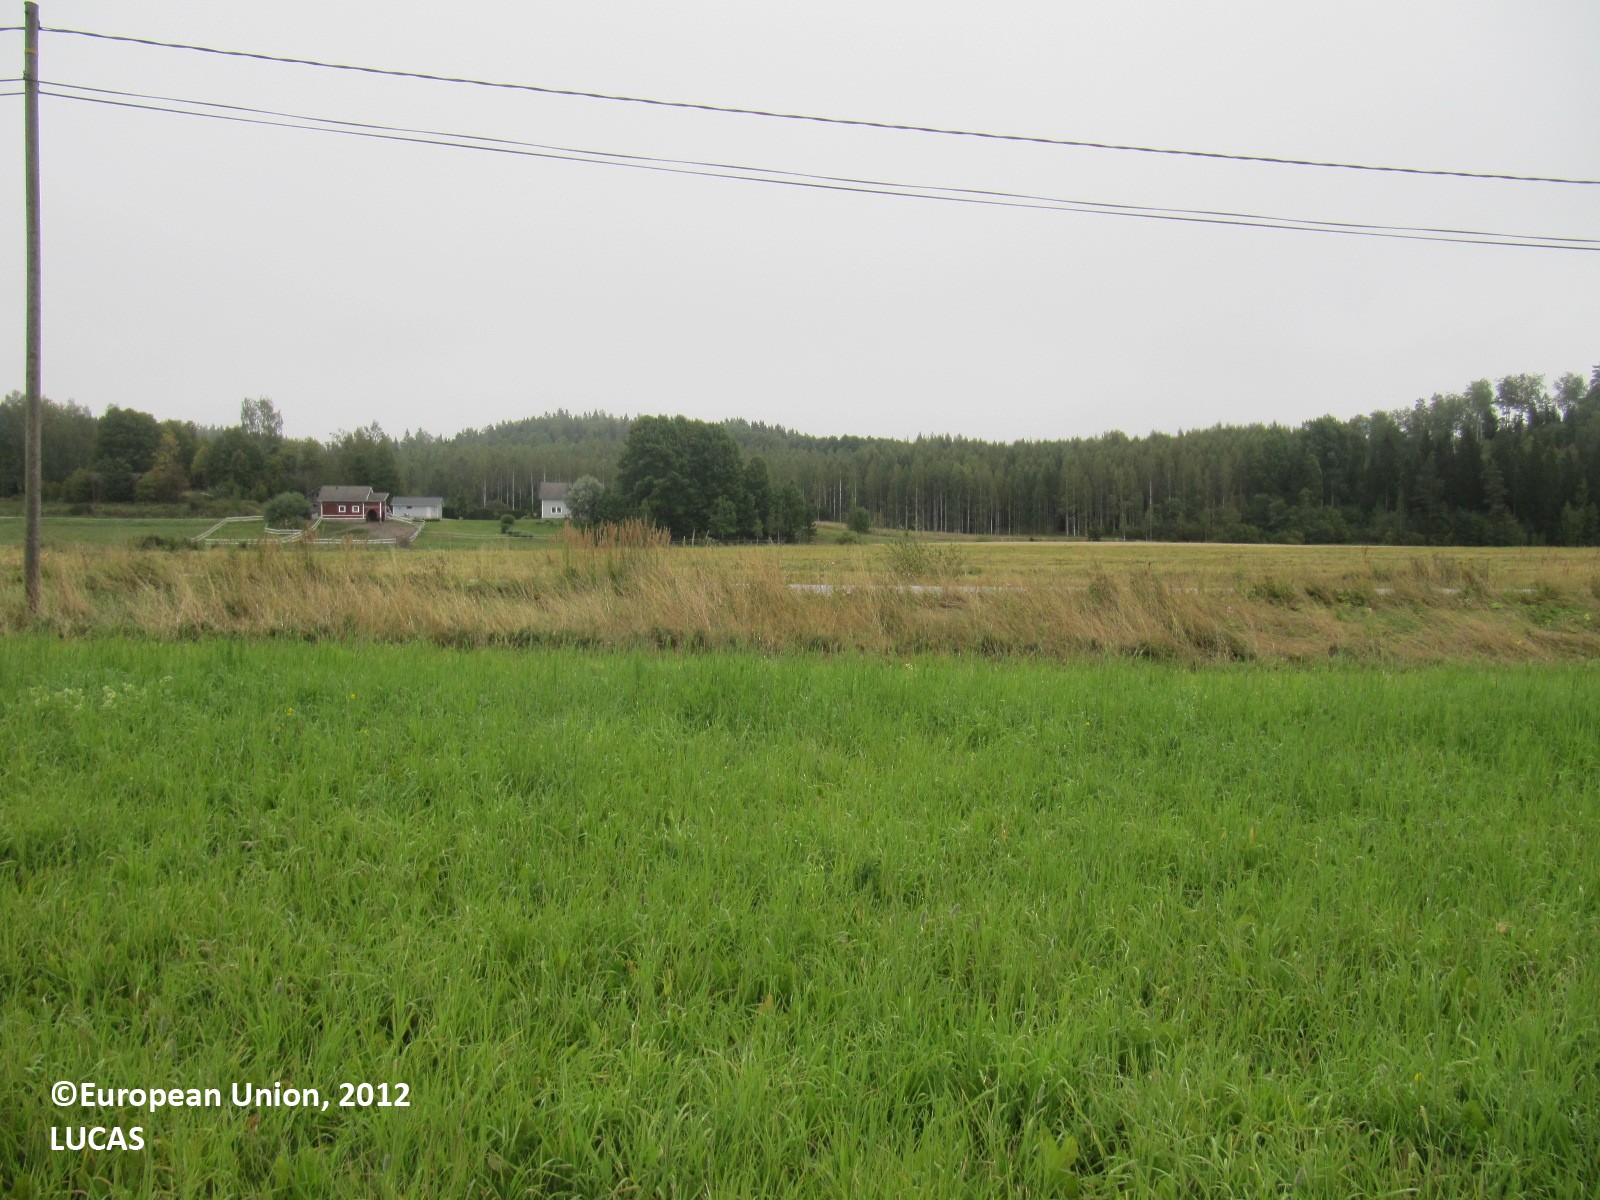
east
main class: Cropland
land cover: Temporary grasslands
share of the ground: > 75 %
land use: Agriculture (excluding fallow land and kitchen gardens)
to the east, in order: Temporary grasslands; Ditches and canals; Electric lines; Spontaneously vegetated surfaces; Paved roads, cycling and walking lanes; Spontaneously vegetated surfaces; Ditches and canals; Temporary grasslands; Spontaneously vegetated surfaces; Ditches and canals; Spontaneously vegetated surfaces; Temporary grasslands; Spontaneously vegetated surfaces; Ditches and canals; Spontaneously vegetated surfaces; Fences; Grassland without tree/shrub cover; Broadleaved woodland; Fences; Broadleaved woodland
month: August
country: FI
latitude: 60.2725
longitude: 24.2957
